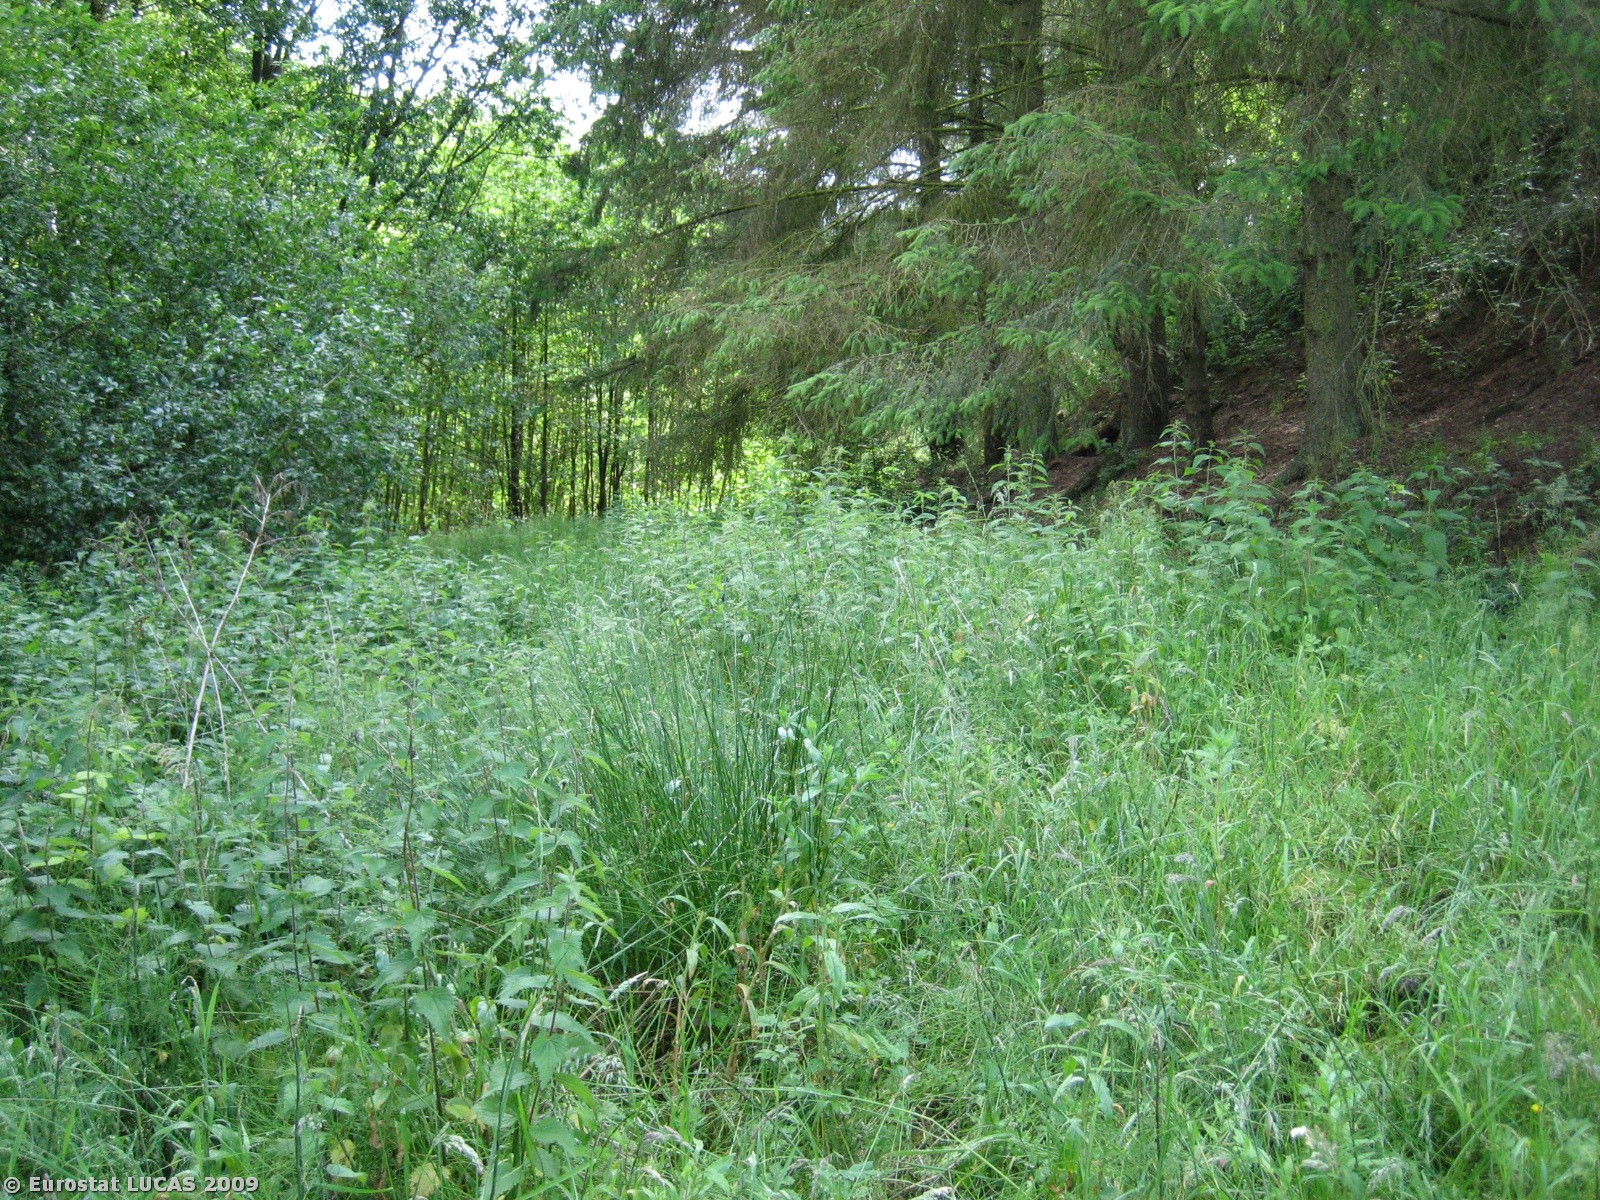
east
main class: Woodland
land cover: Broadleaved woodland
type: non-riverine alder, birch or aspen forest
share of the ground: > 75 %
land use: Agriculture (excluding fallow land and kitchen gardens)
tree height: > 5 m
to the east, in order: Broadleaved woodland; Grassland with sparse tree/shrub cover; Fences; Broadleaved woodland; Grassland with sparse tree/shrub cover; Single bushes/trees; Grassland without tree/shrub cover
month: June
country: DK
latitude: 55.6123
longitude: 9.7304
